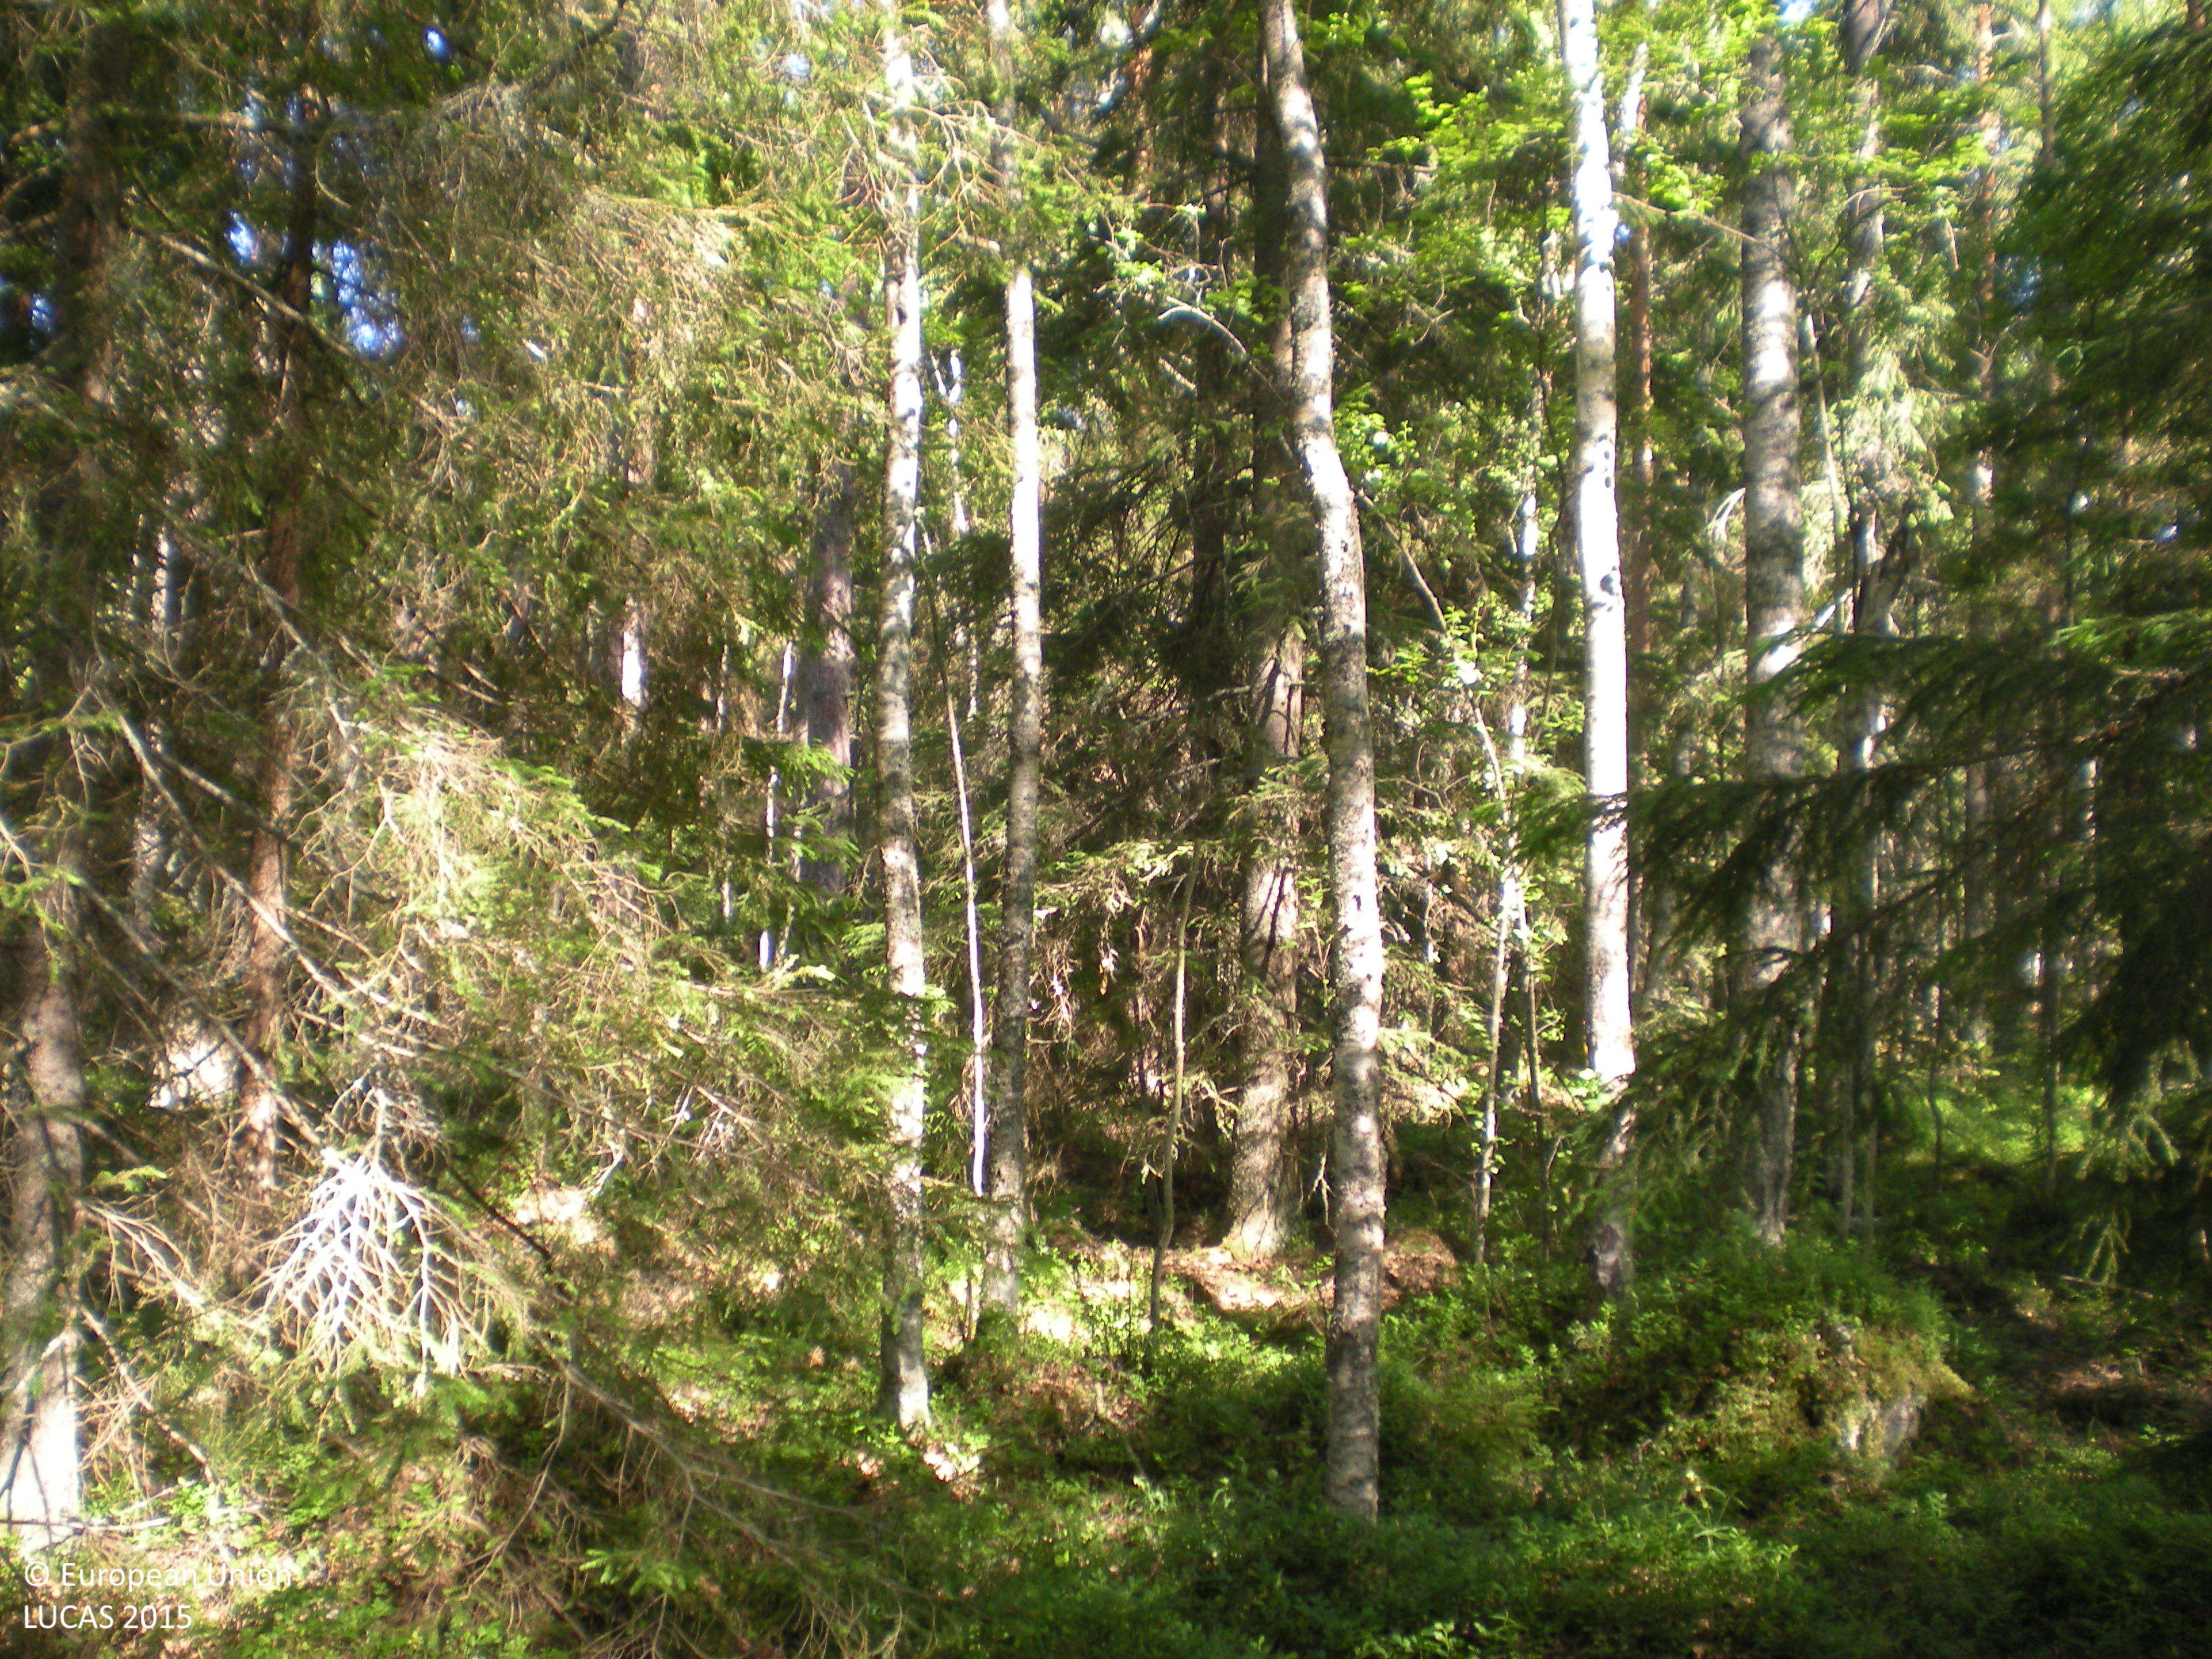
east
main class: Woodland
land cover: Pine dominated mixed woodland
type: boreal forest
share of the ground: 50 - 75 %
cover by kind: coniferous forest trees 60 %, broadleaved forest trees 20 %, shrubs 15 %, herbaceous plants 5 %
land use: Forestry
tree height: > 5 m
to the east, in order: Pine dominated mixed woodland; Other mixed woodland; Spruce dominated coniferous woodland; Spruce dominated mixed woodland; Other coniferous woodland; Ditches and canals; Other coniferous woodland; Grassland with sparse tree/shrub cover; Pine dominated mixed woodland; Broadleaved woodland
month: July
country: SE
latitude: 60.5274
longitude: 17.7720
